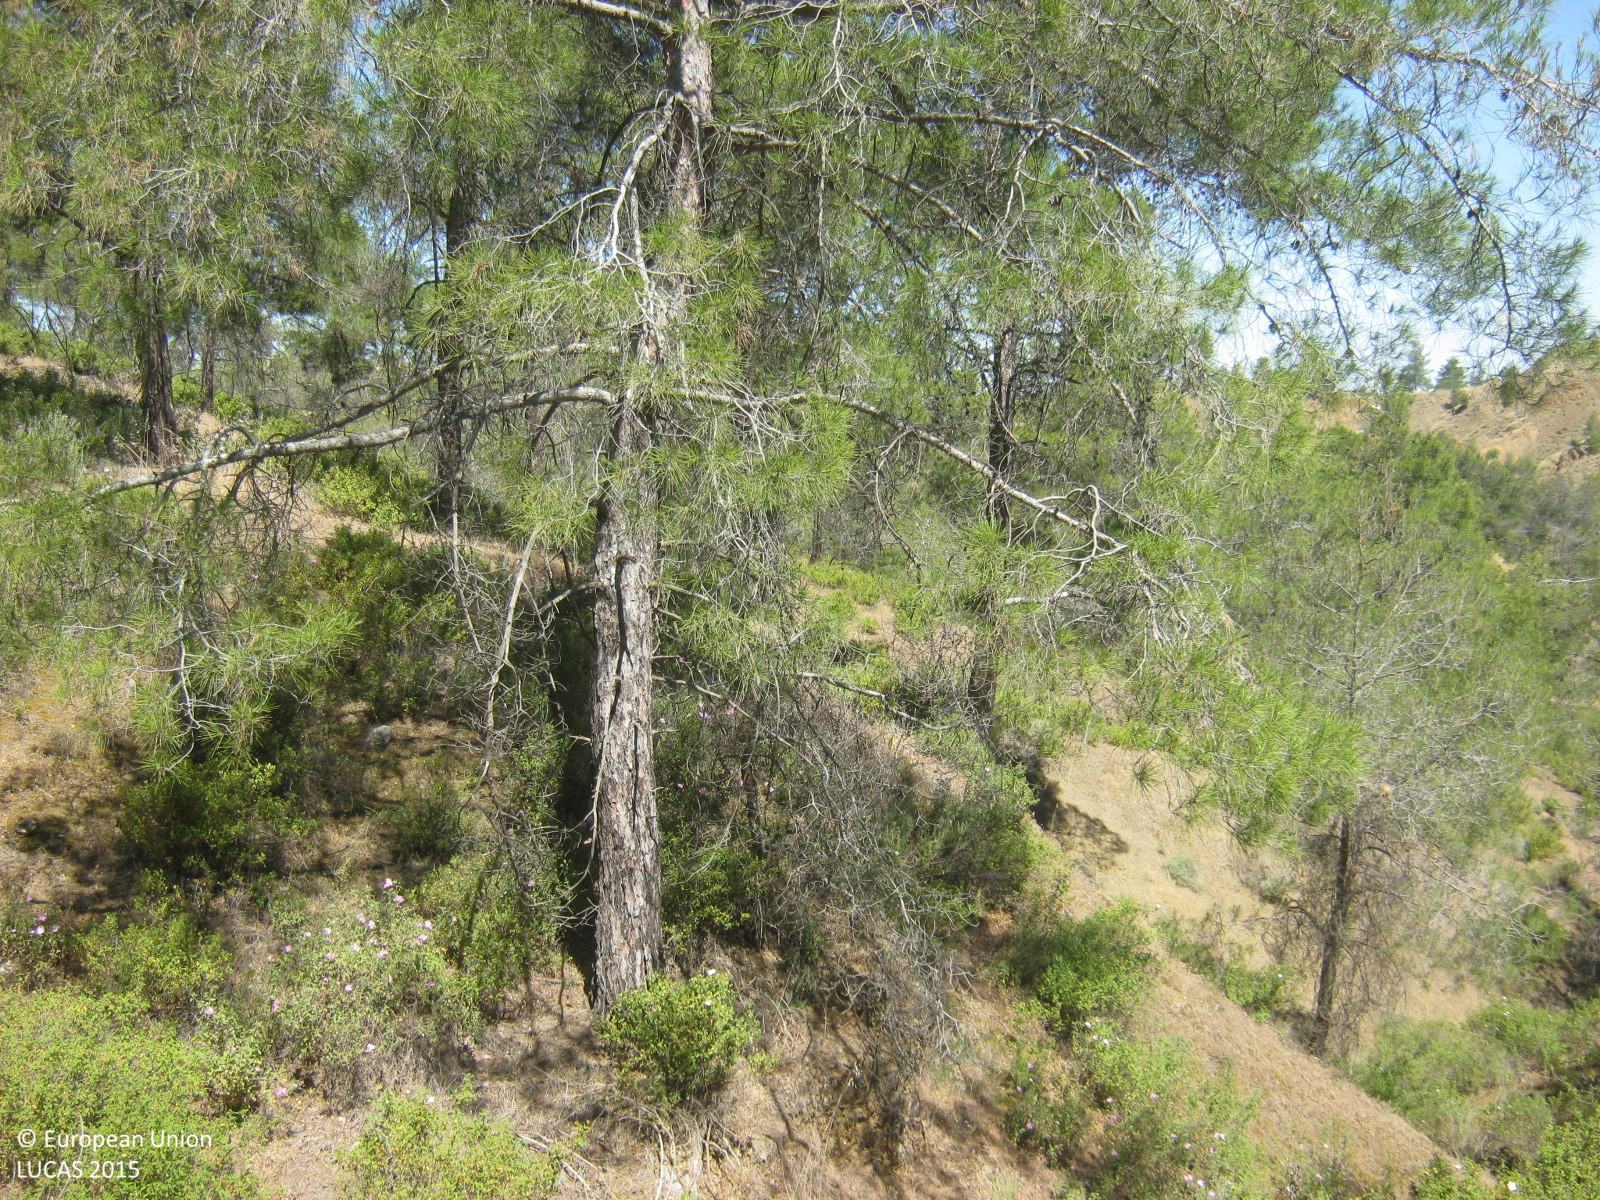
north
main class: Woodland
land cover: Pine dominated coniferous woodland
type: coniferous forest of the mediterranean region
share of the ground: > 75 %
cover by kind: coniferous forest trees 75 %, shrubs 10 %, herbaceous plants 10 %, unconsolidated bare surface 5 %
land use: Forestry
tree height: > 5 m
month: May
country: CY
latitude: 34.9989
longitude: 33.2245
